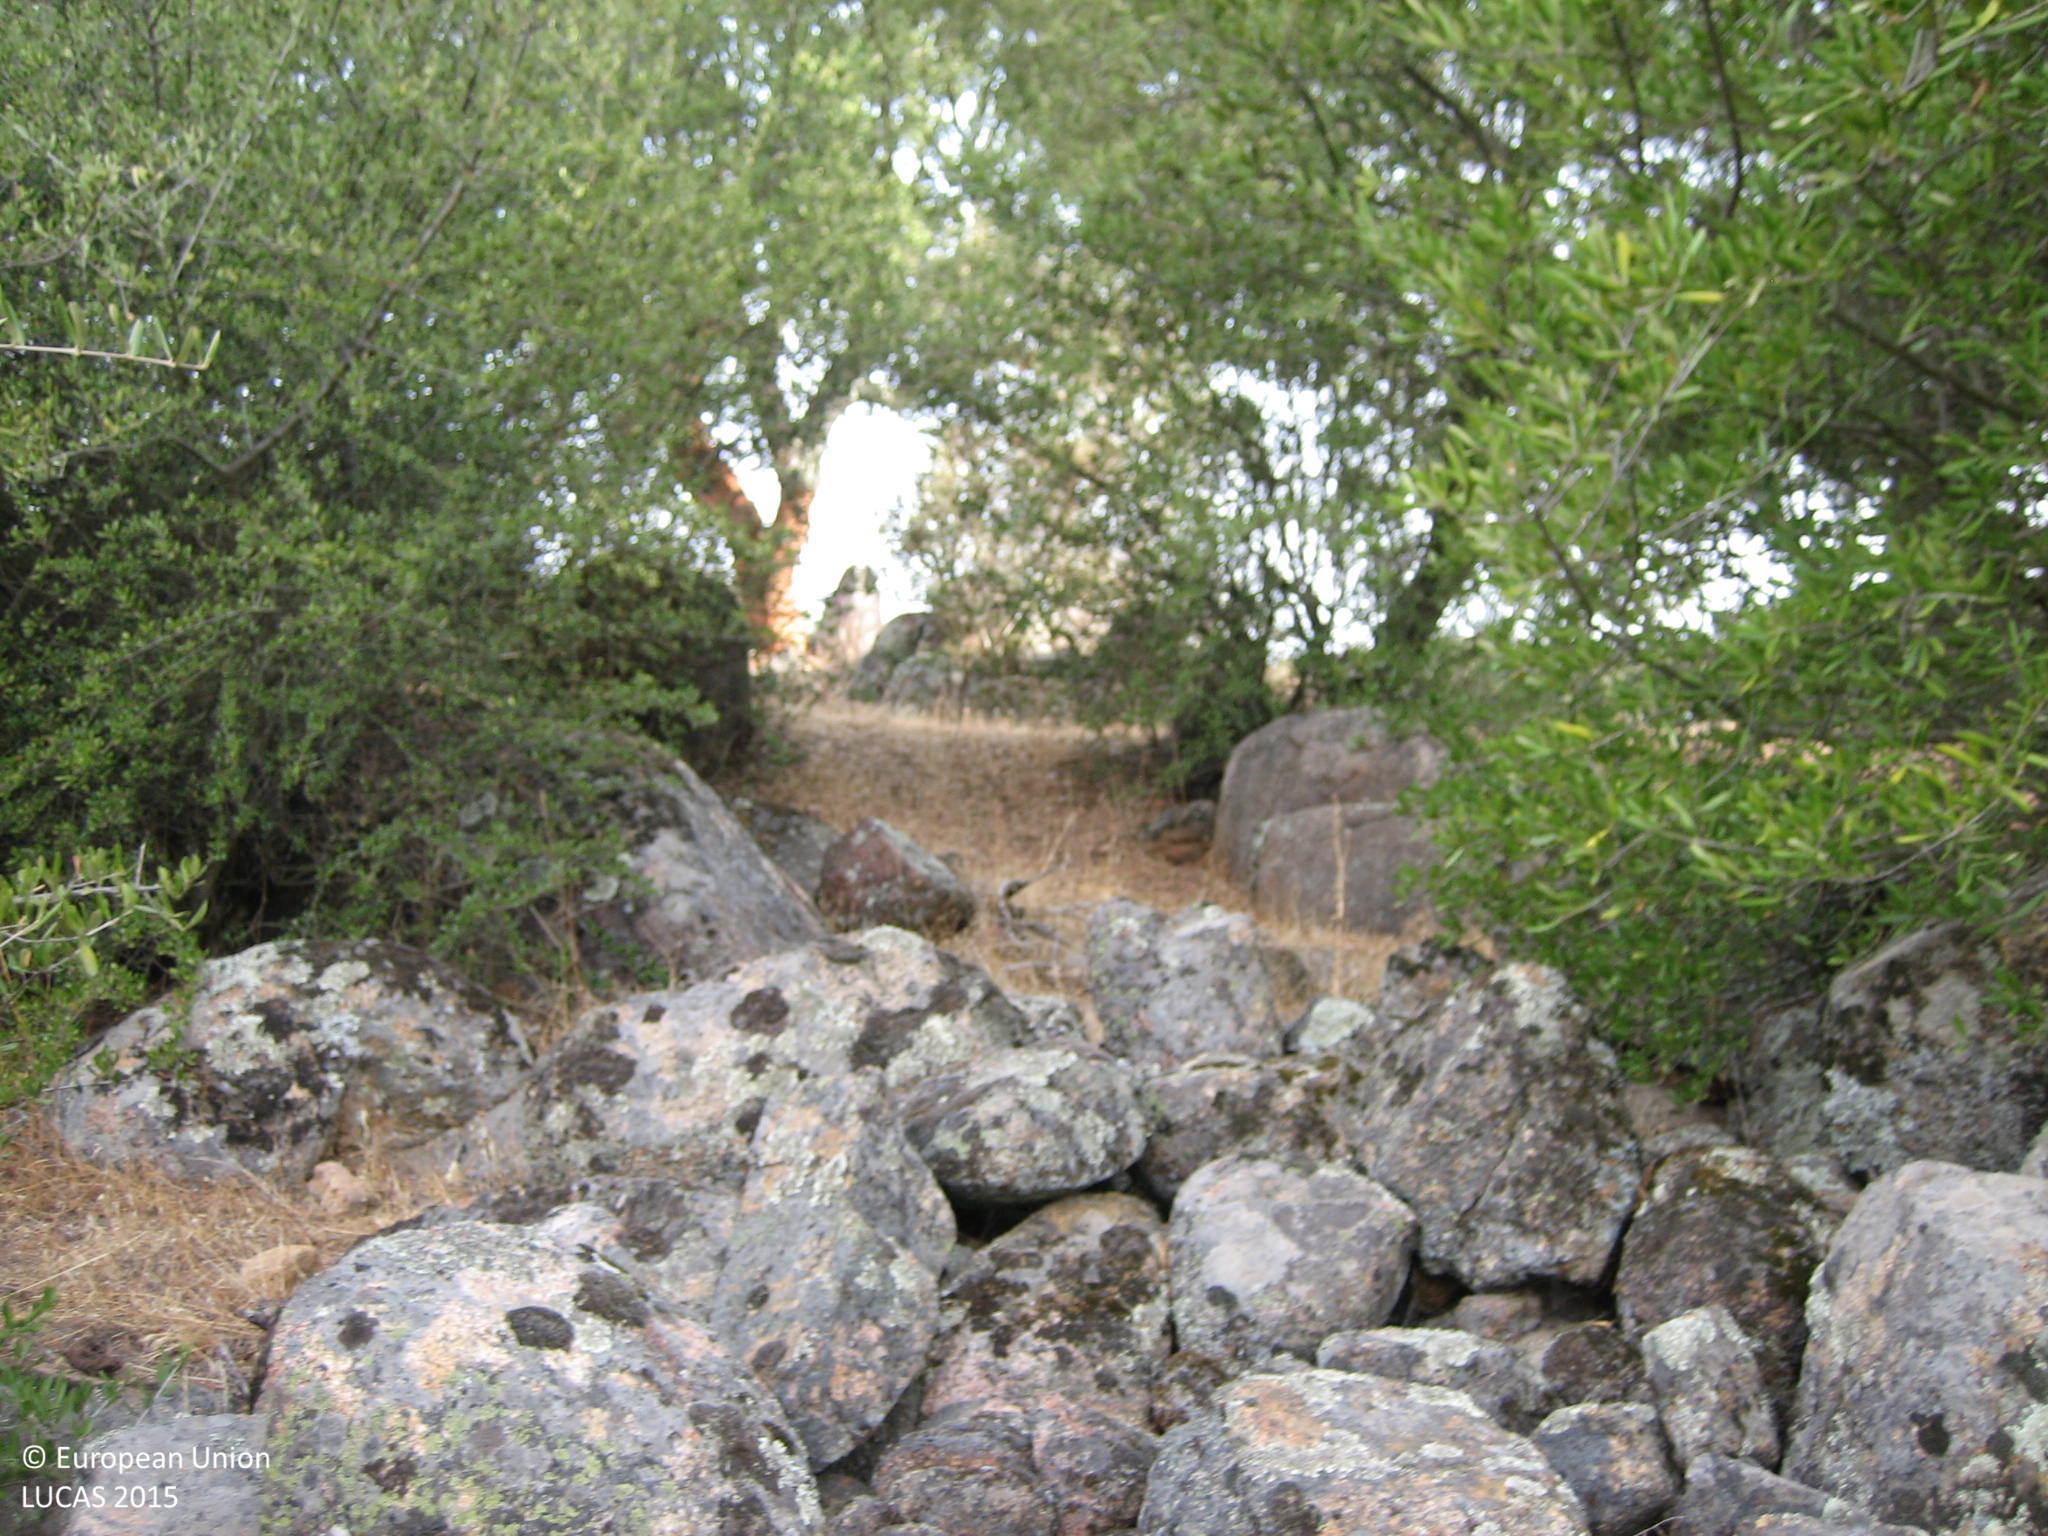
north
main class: Woodland
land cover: Broadleaved woodland
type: broadleaved evergreen forest
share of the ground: 50 - 75 %
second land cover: Grassland without tree/shrub cover
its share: 25 - 50 %
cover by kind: broadleaved forest trees 50 %, herbaceous plants 25 %, consolidated bare surface 20 %, shrubs 5 %
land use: Forestry
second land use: Agriculture (excluding fallow land and kitchen gardens)
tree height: > 5 m
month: September
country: ES
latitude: 38.5583
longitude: -6.8503
